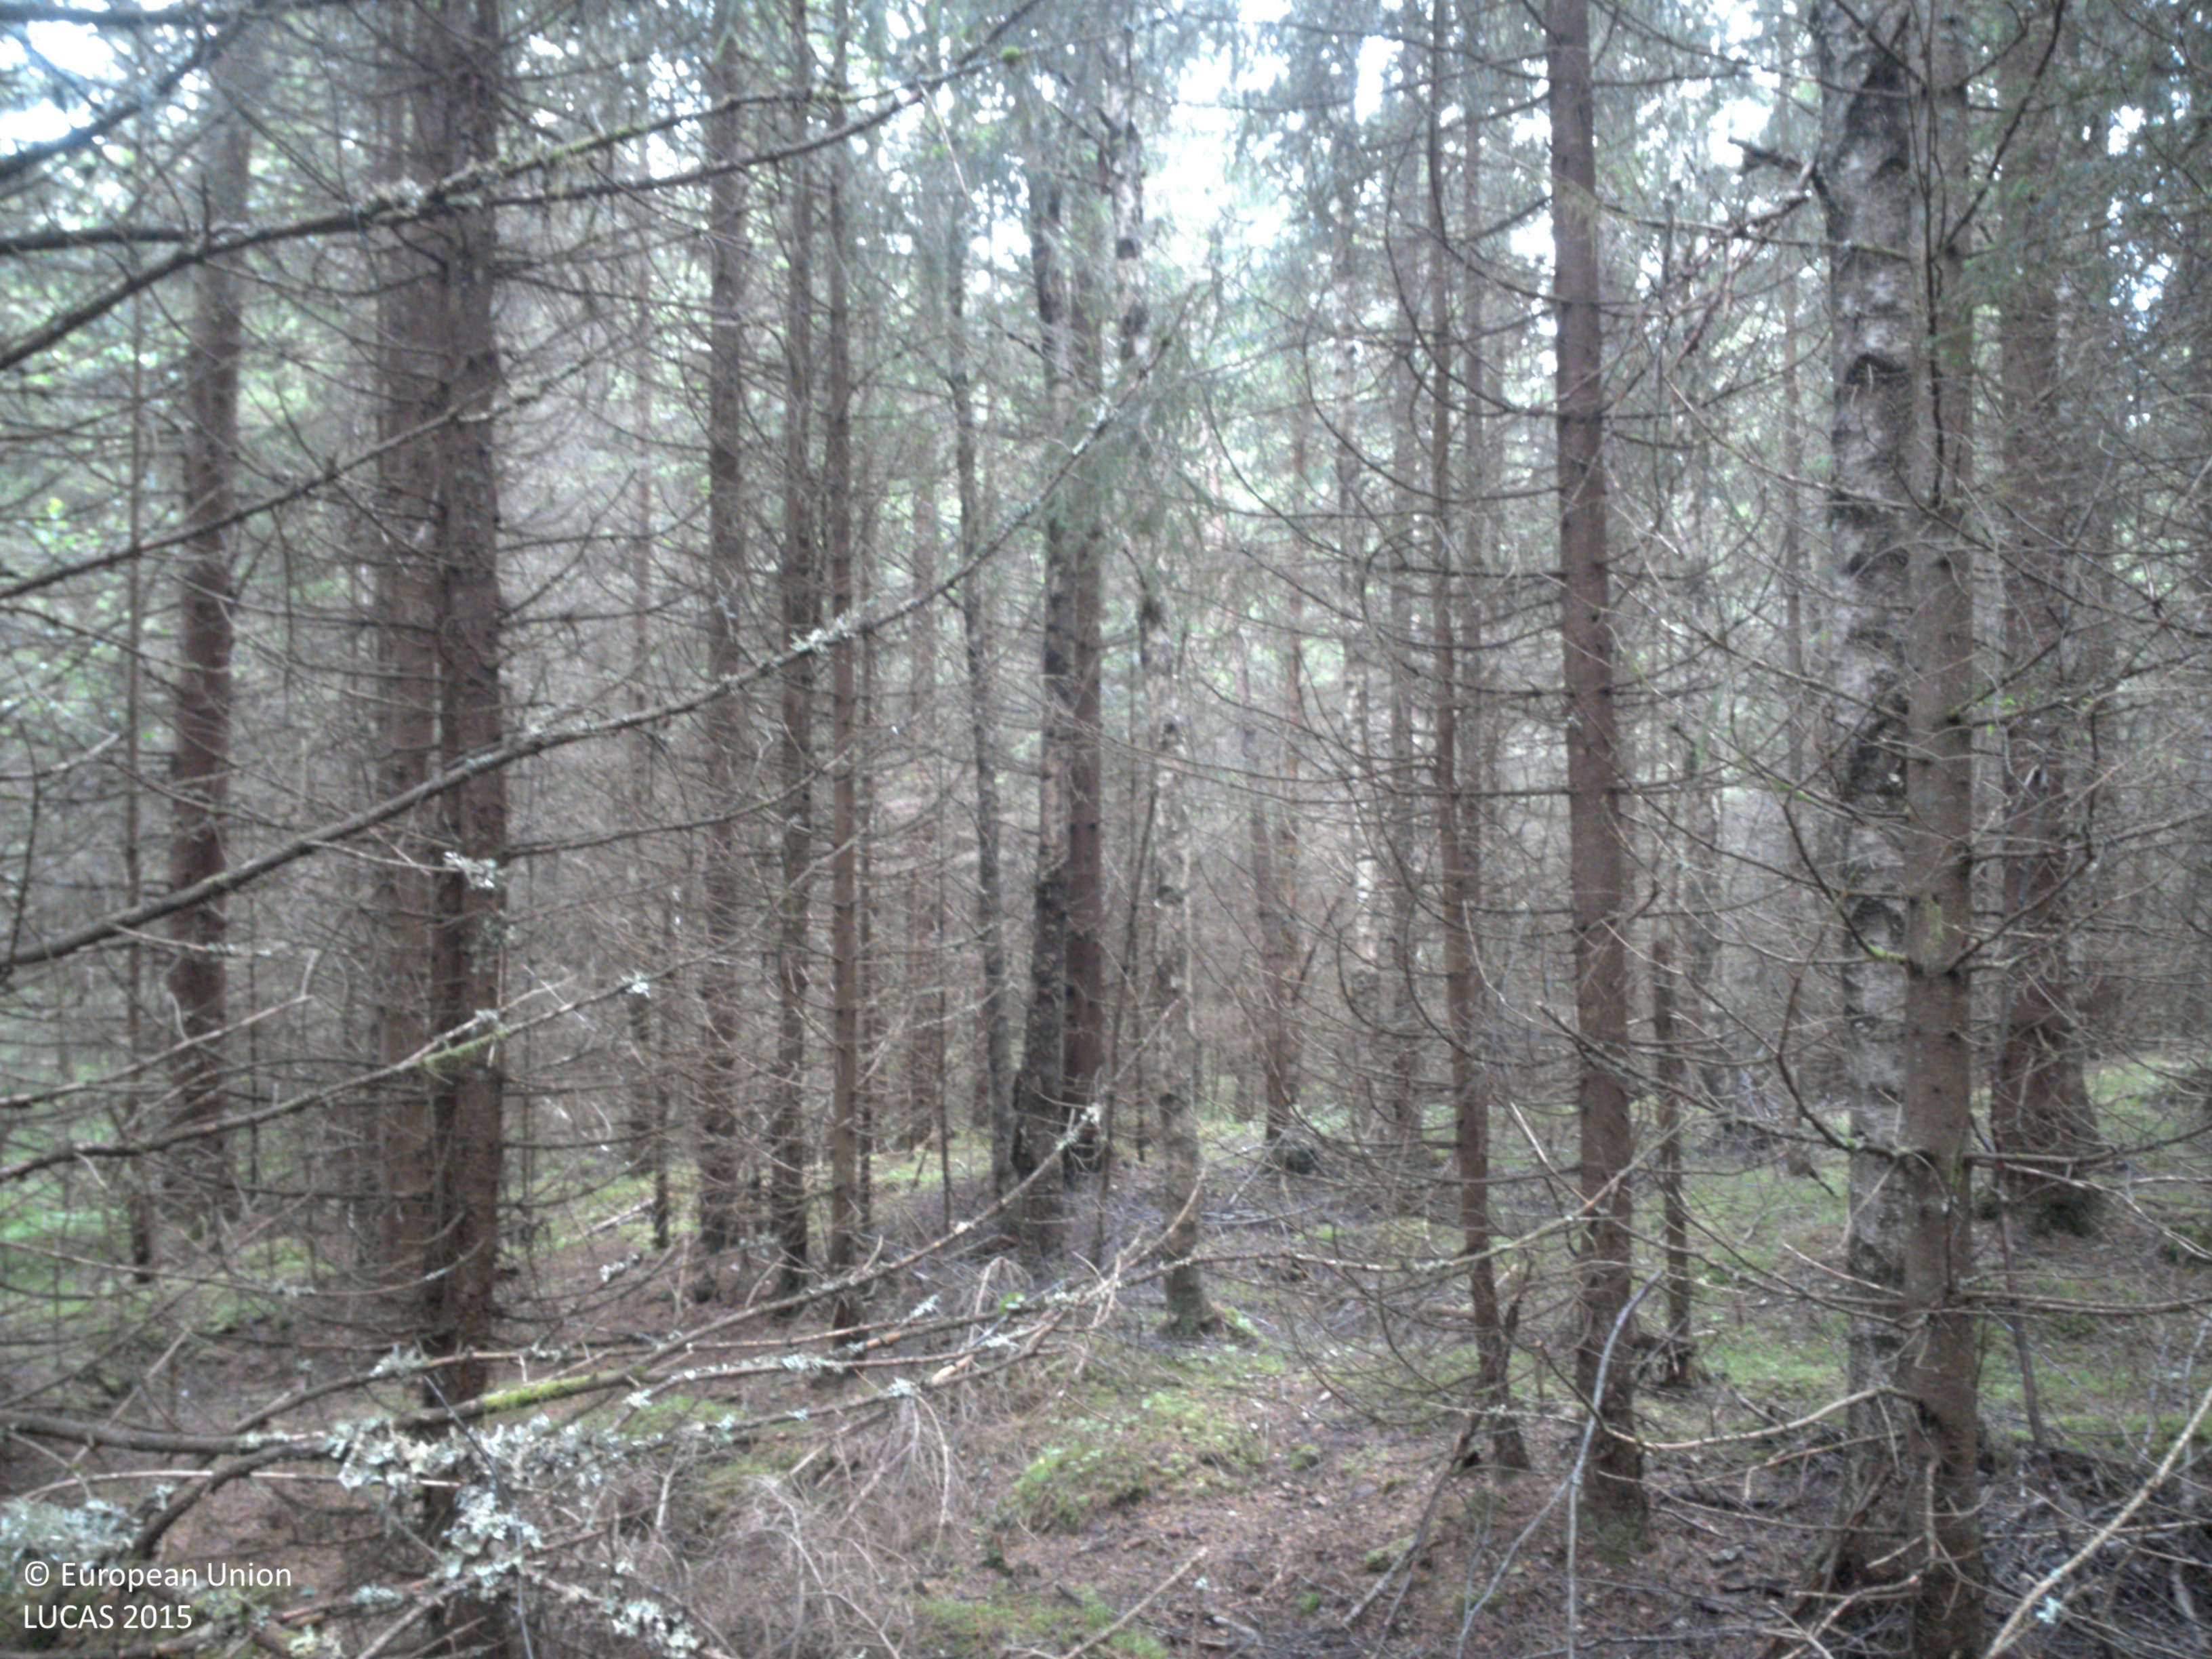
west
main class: Woodland
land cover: Spruce dominated coniferous woodland
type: boreal forest
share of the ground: > 75 %
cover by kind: coniferous forest trees 80 %, lichens and mosses 20 %
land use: Forestry
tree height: > 5 m
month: July
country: SE
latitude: 58.8351
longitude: 11.9533
